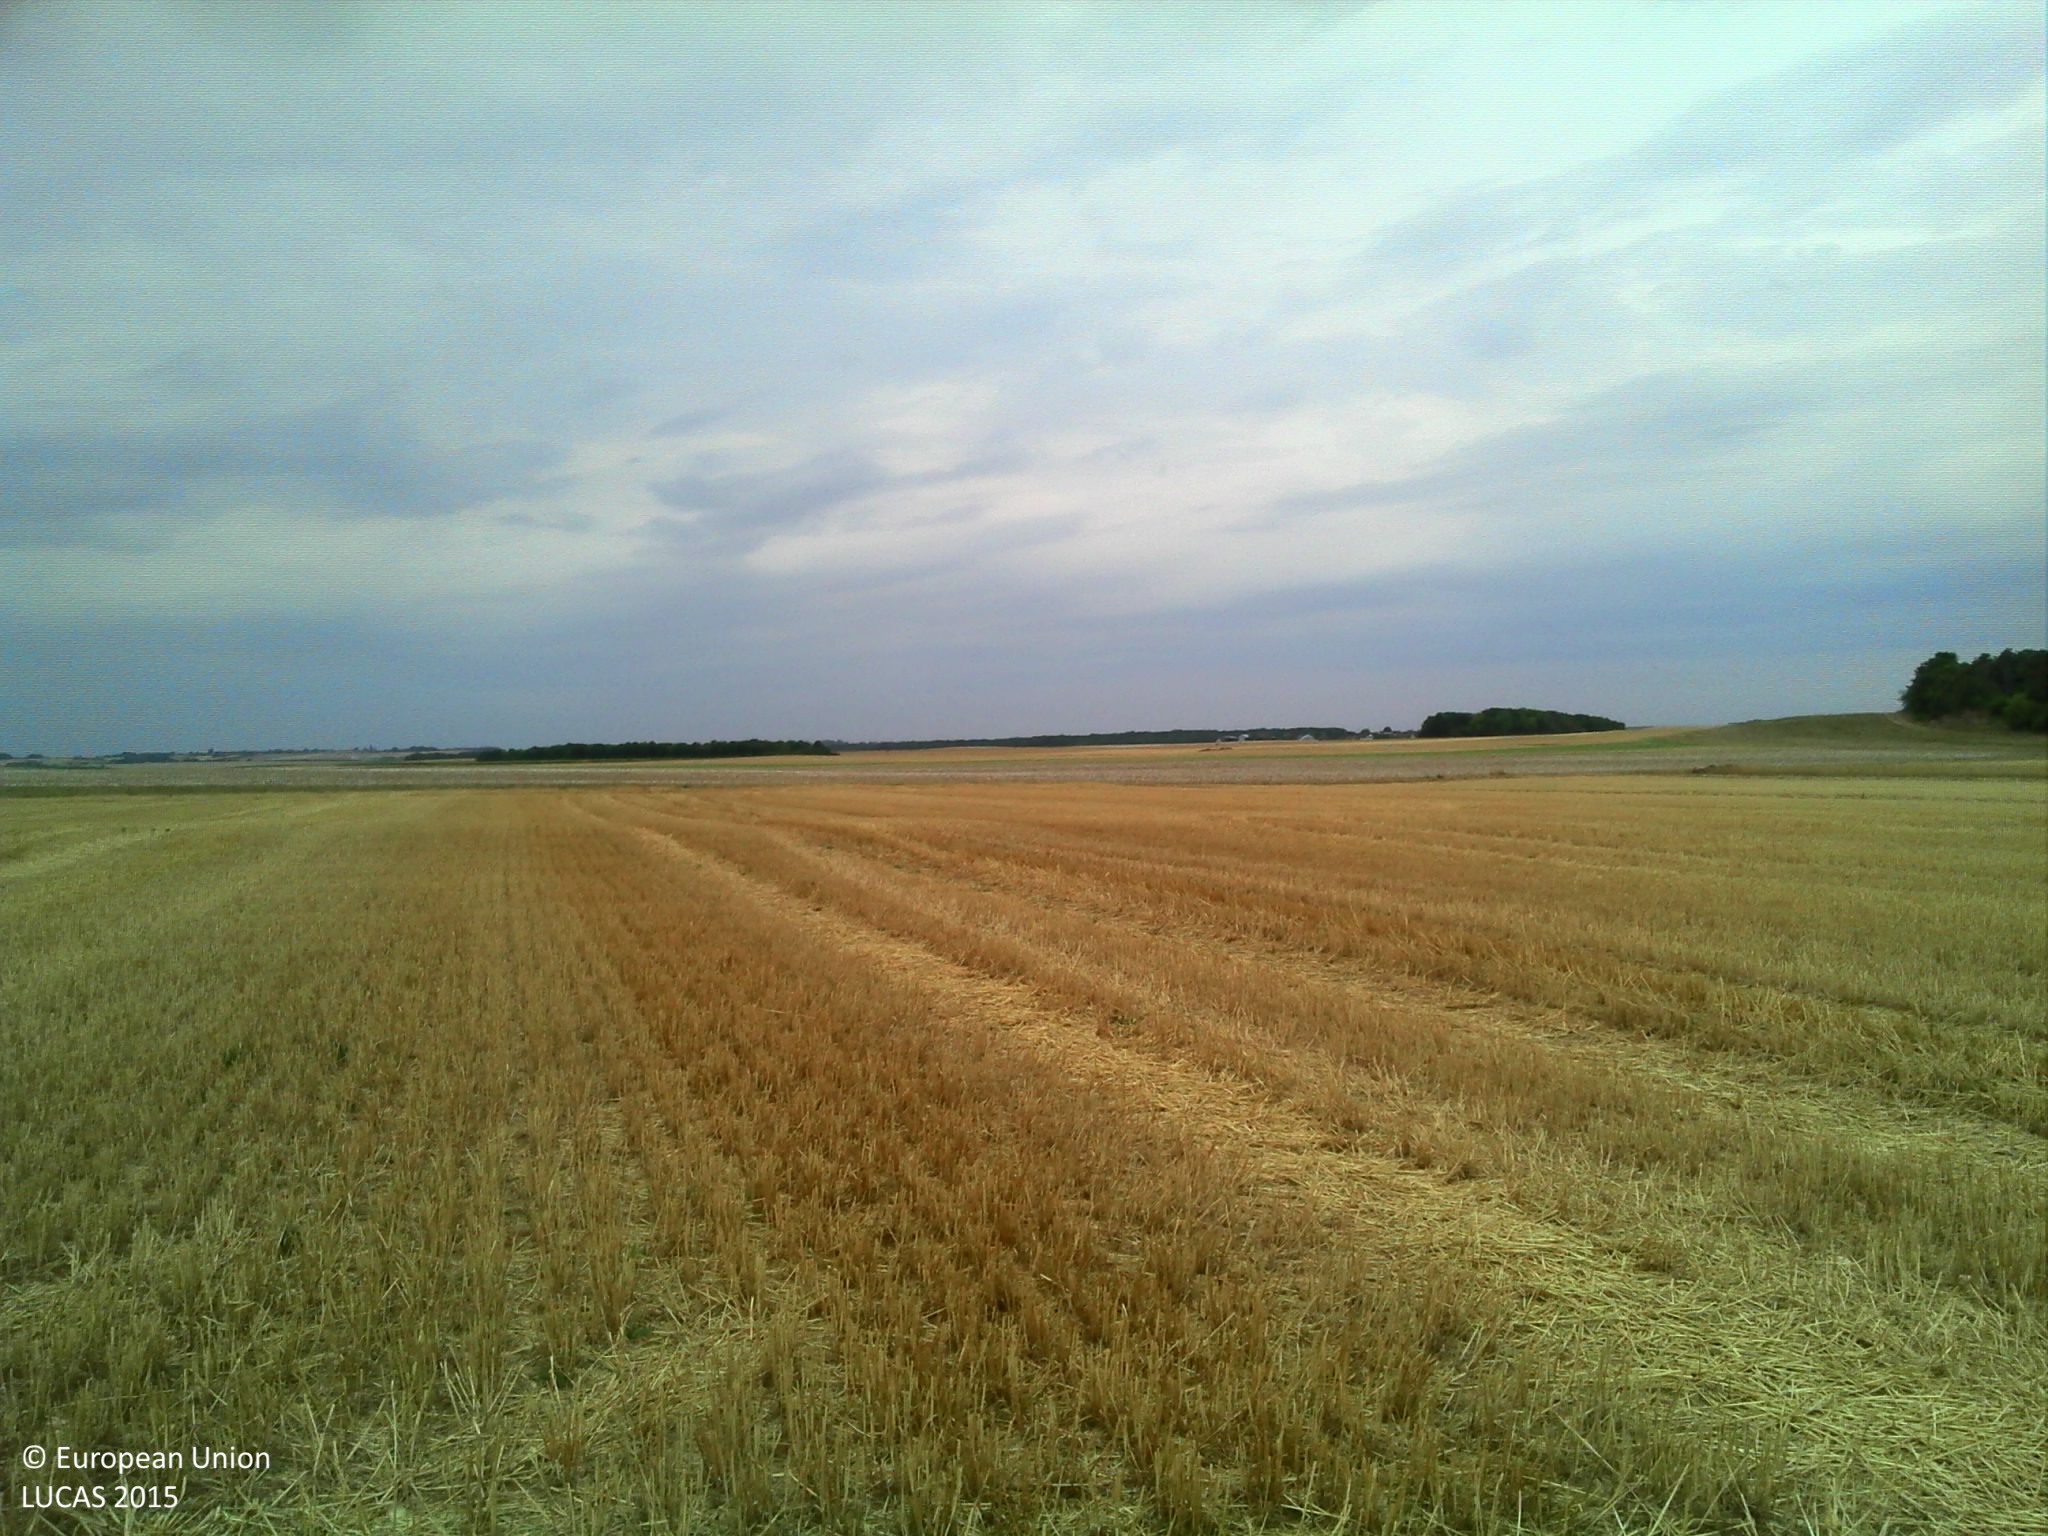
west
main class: Cropland
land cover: Common wheat
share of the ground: > 75 %
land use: Agriculture (excluding fallow land and kitchen gardens)
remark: Harvested field
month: August
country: FR
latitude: 48.1685
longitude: 2.5275
